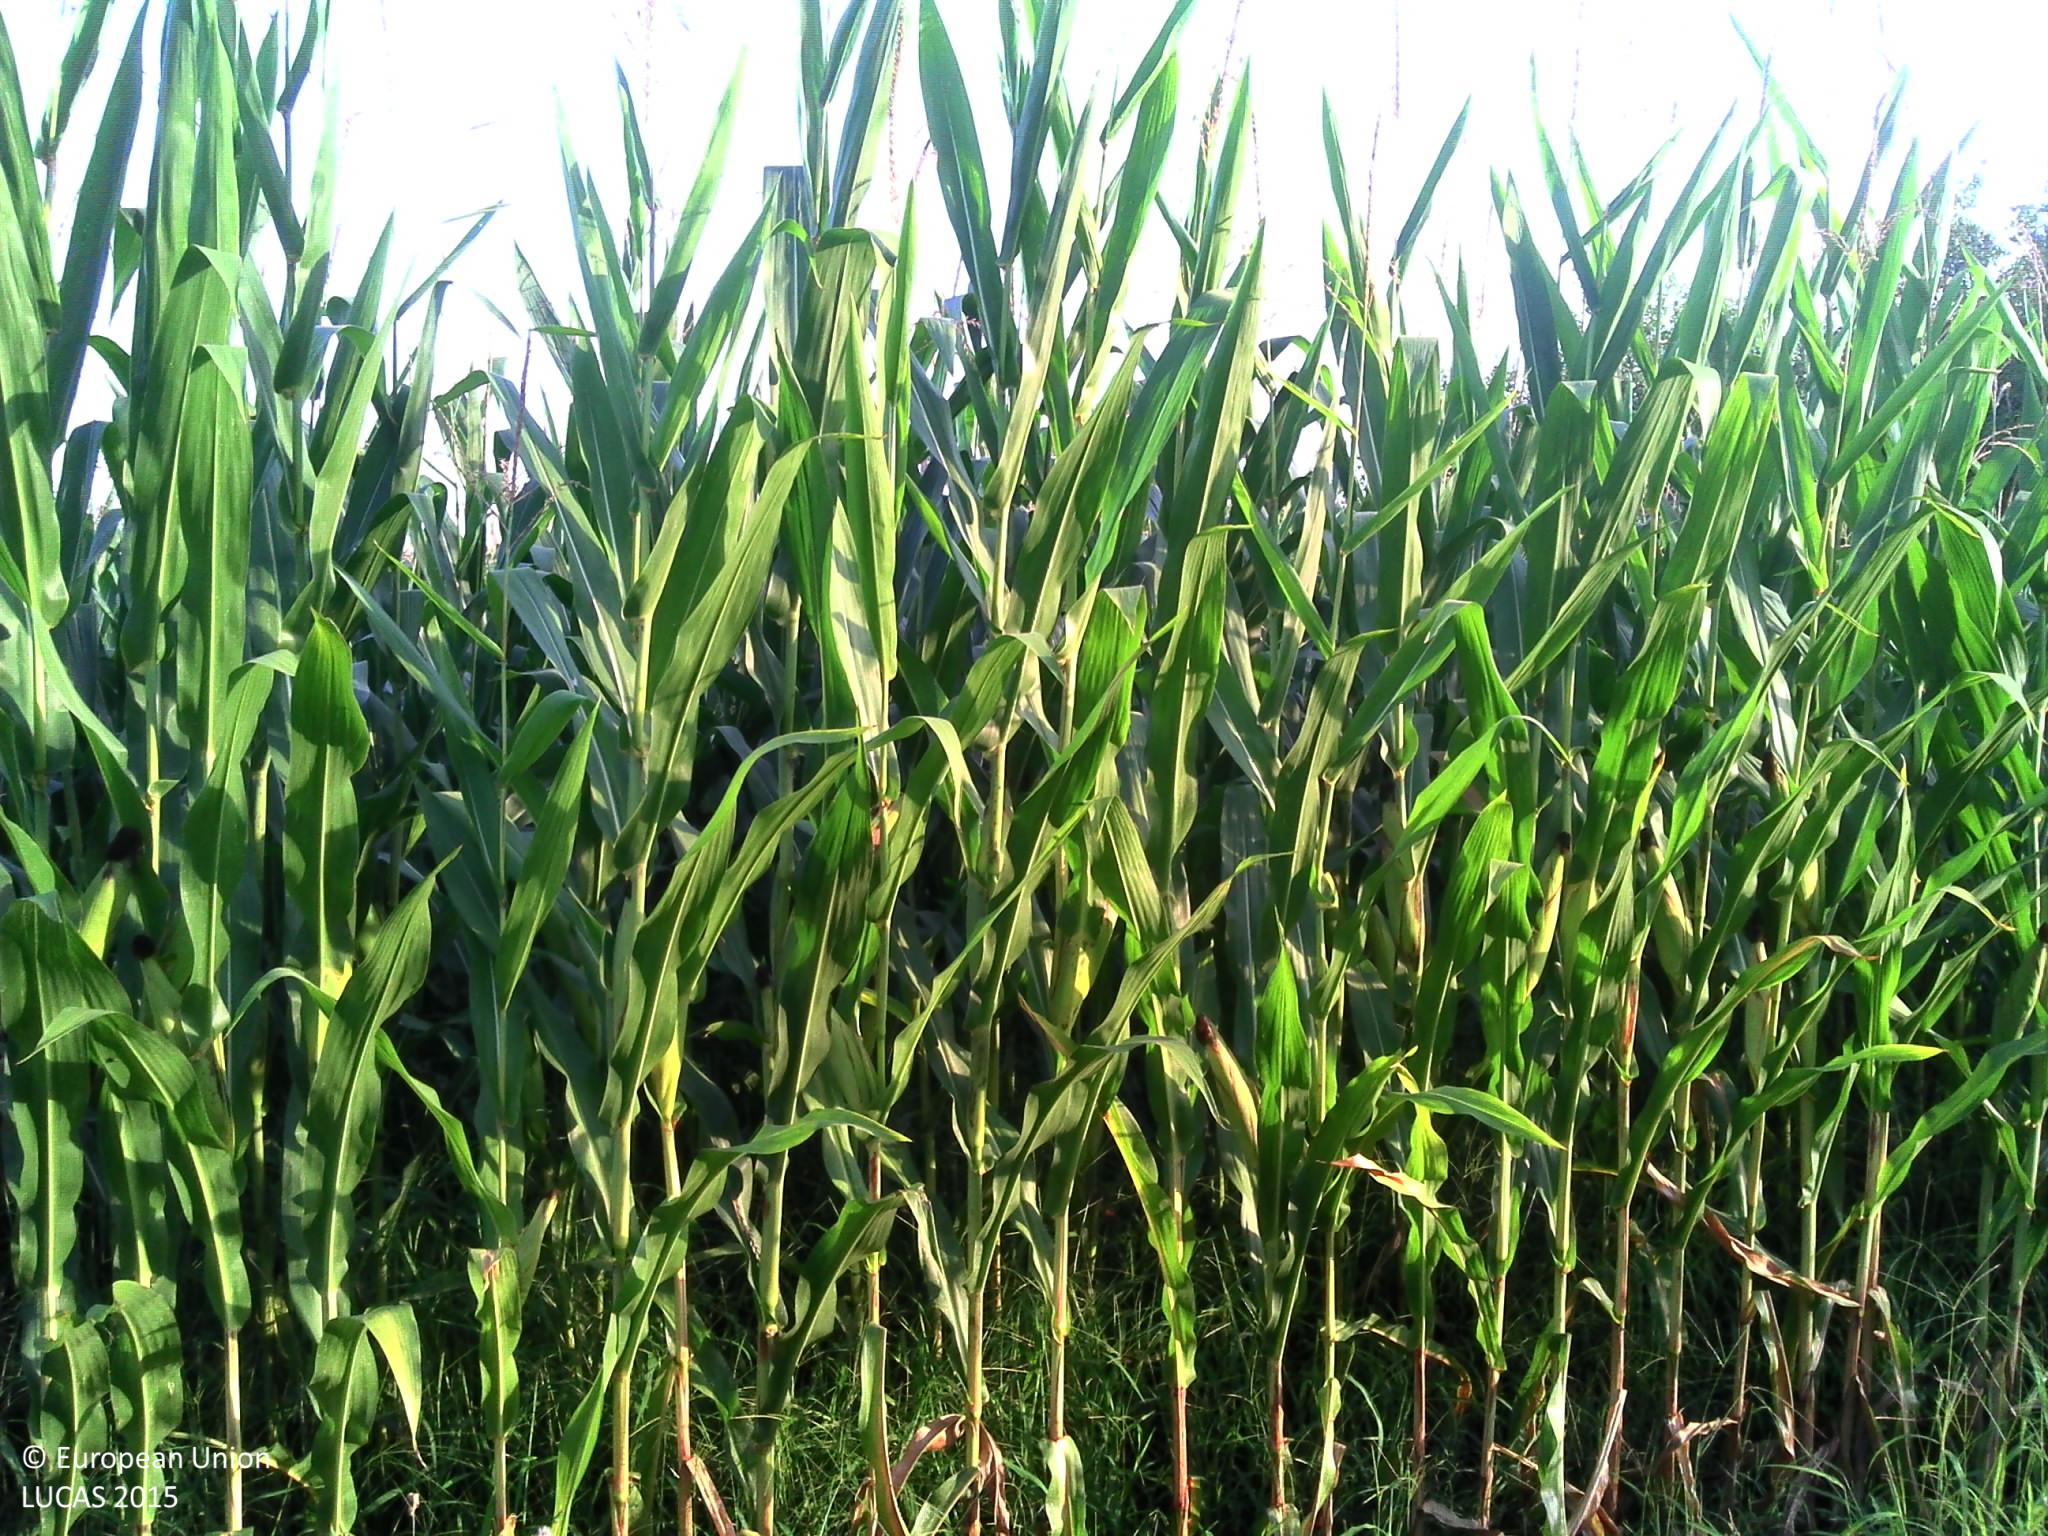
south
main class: Cropland
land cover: Other fruit trees and berries
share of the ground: 25 - 50 %
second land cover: Grassland without tree/shrub cover
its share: 50 - 75 %
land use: Kitchen garden
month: August
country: FR
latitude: 45.1311
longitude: 0.5164
